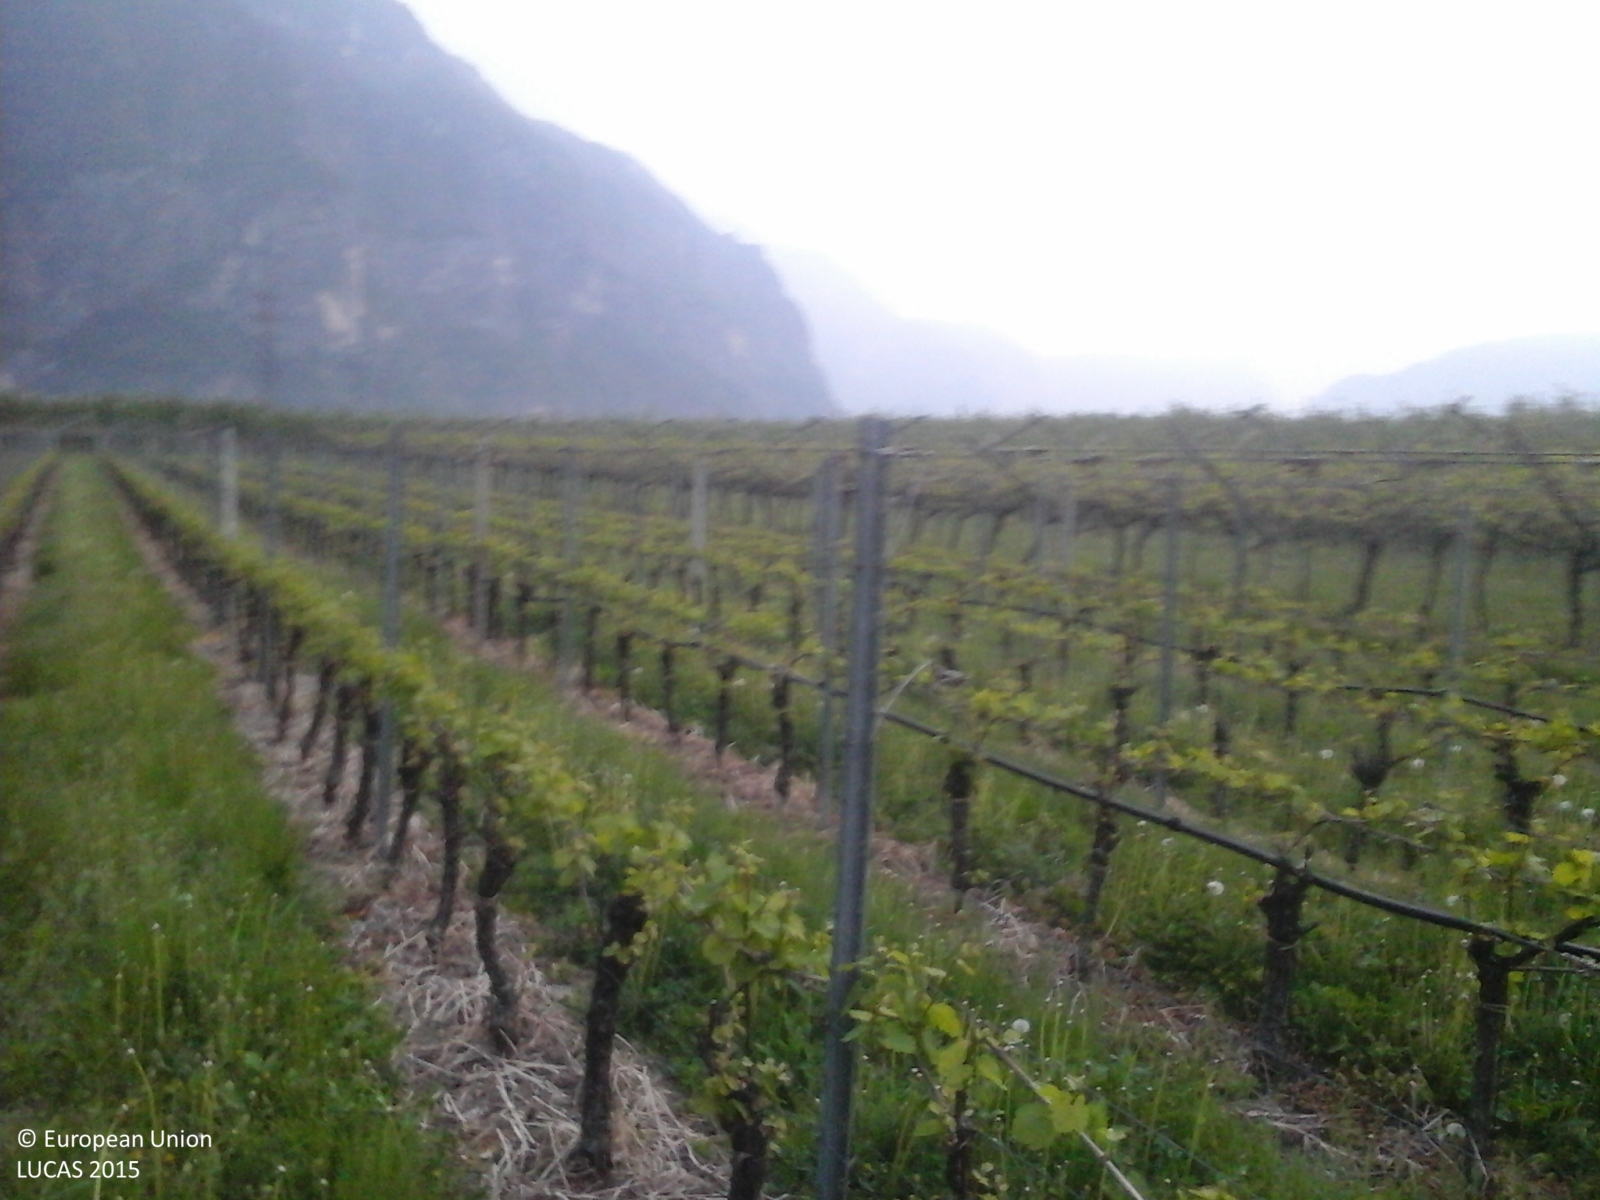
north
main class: Cropland
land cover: Vineyards
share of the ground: < 10 %
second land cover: Grassland without tree/shrub cover
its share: > 75 %
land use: Agriculture (excluding fallow land and kitchen gardens)
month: April
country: IT
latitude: 46.1477
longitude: 11.0731
